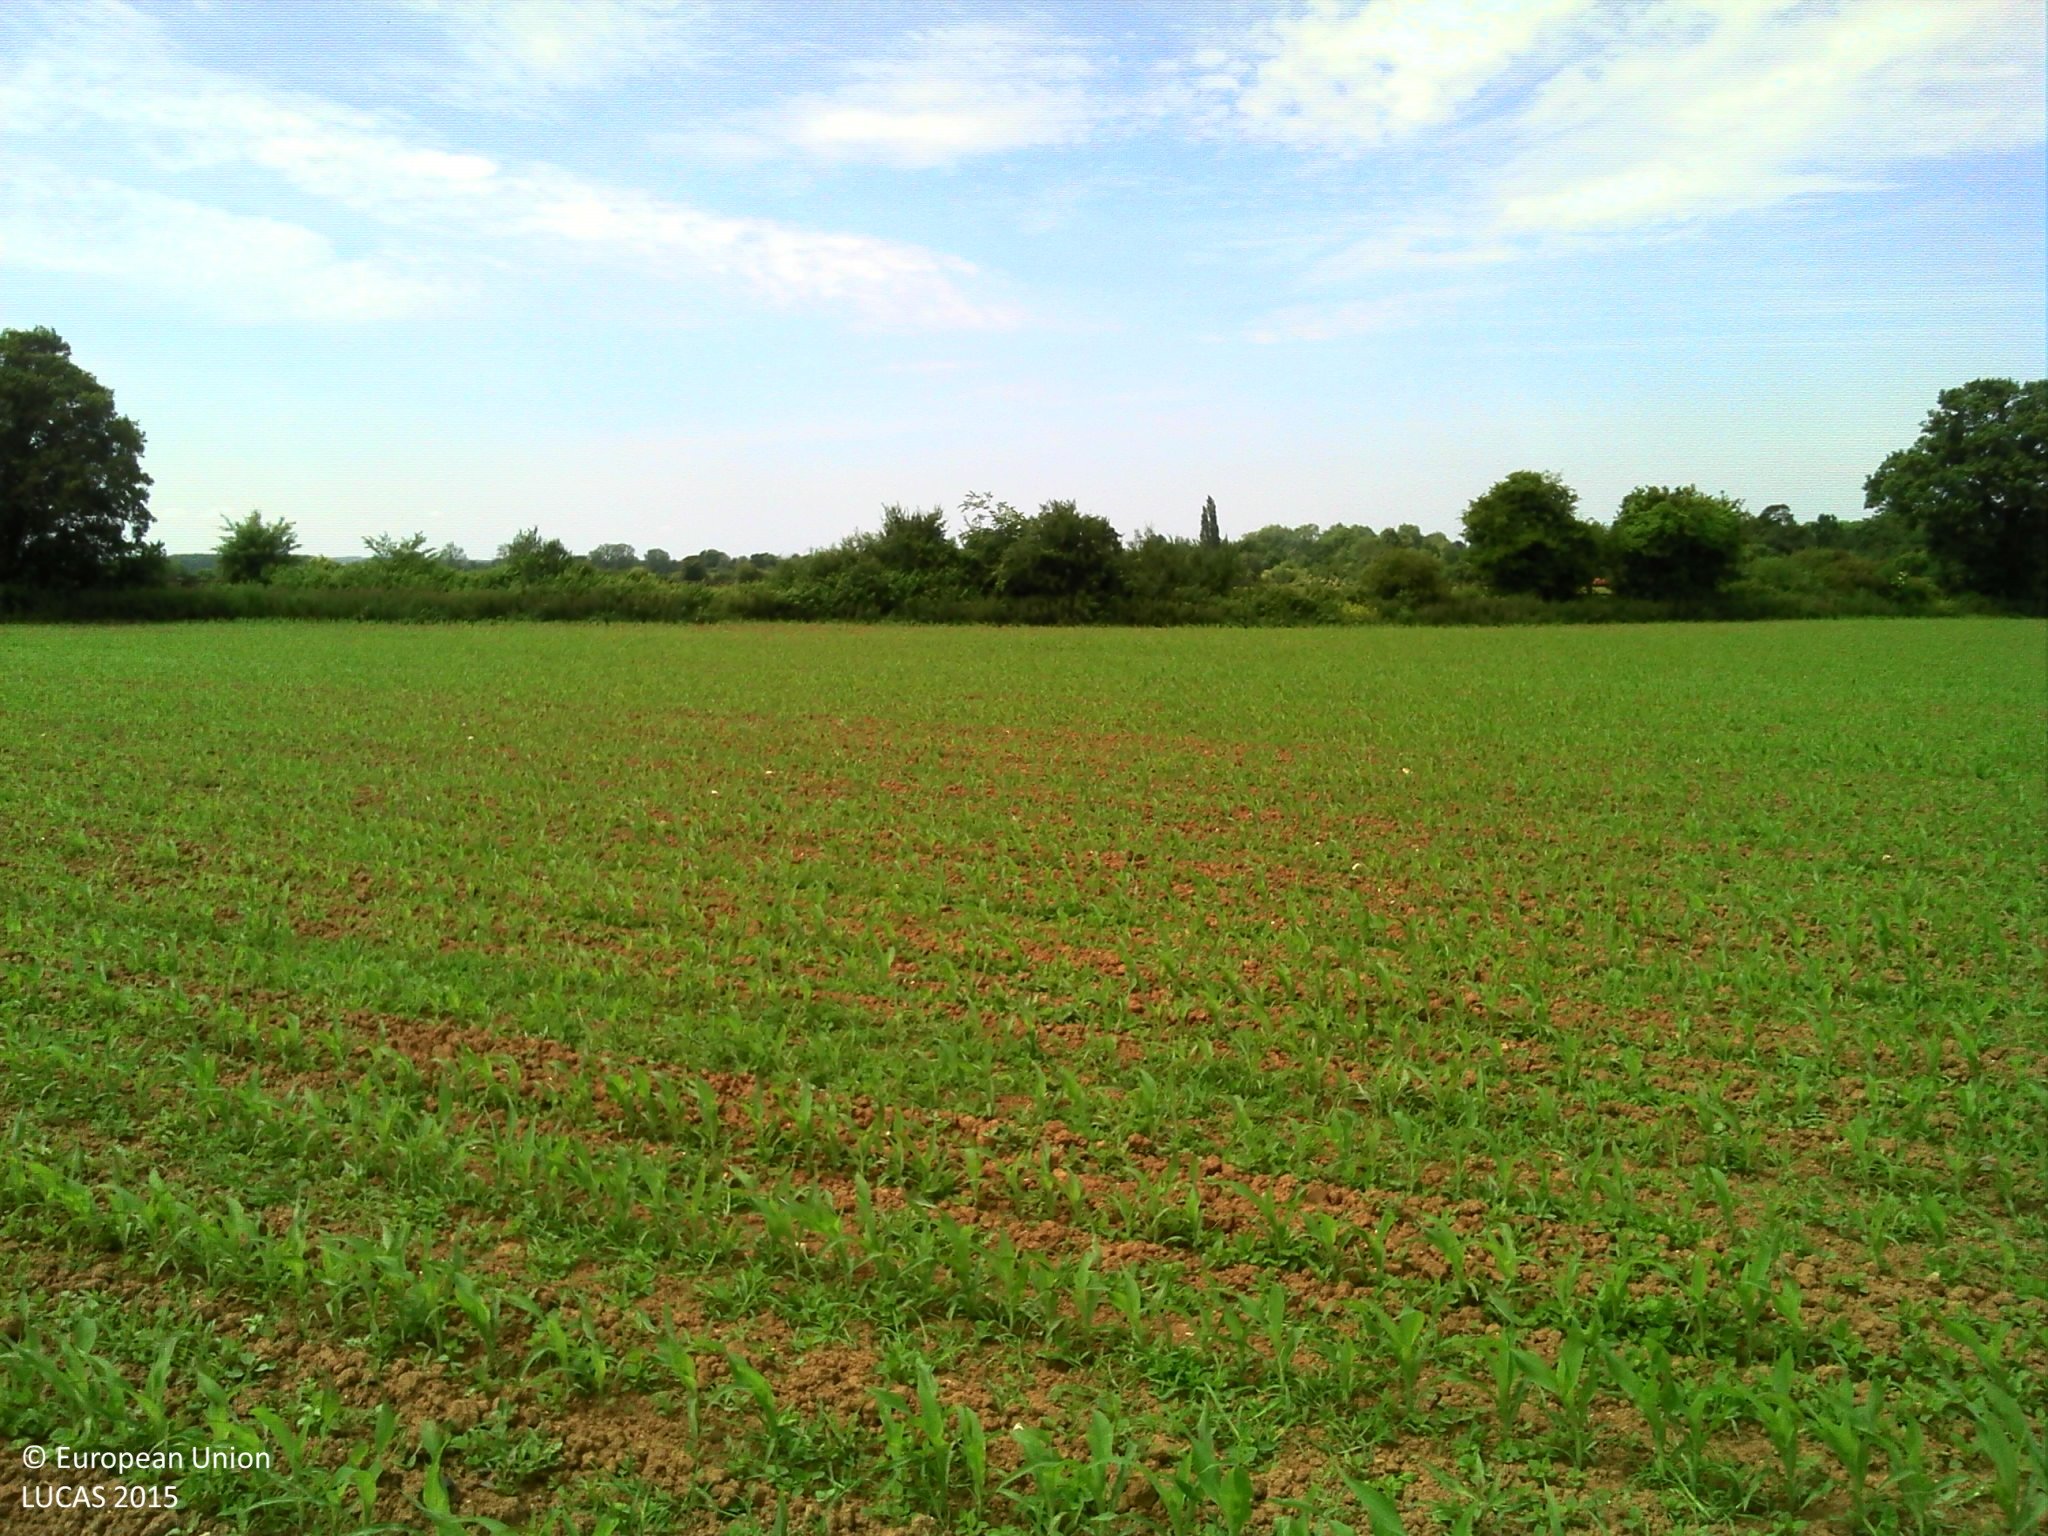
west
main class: Cropland
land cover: Maize
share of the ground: 10 - 25 %
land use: Agriculture (excluding fallow land and kitchen gardens)
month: June
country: FR
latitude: 49.1635
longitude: -0.0010
